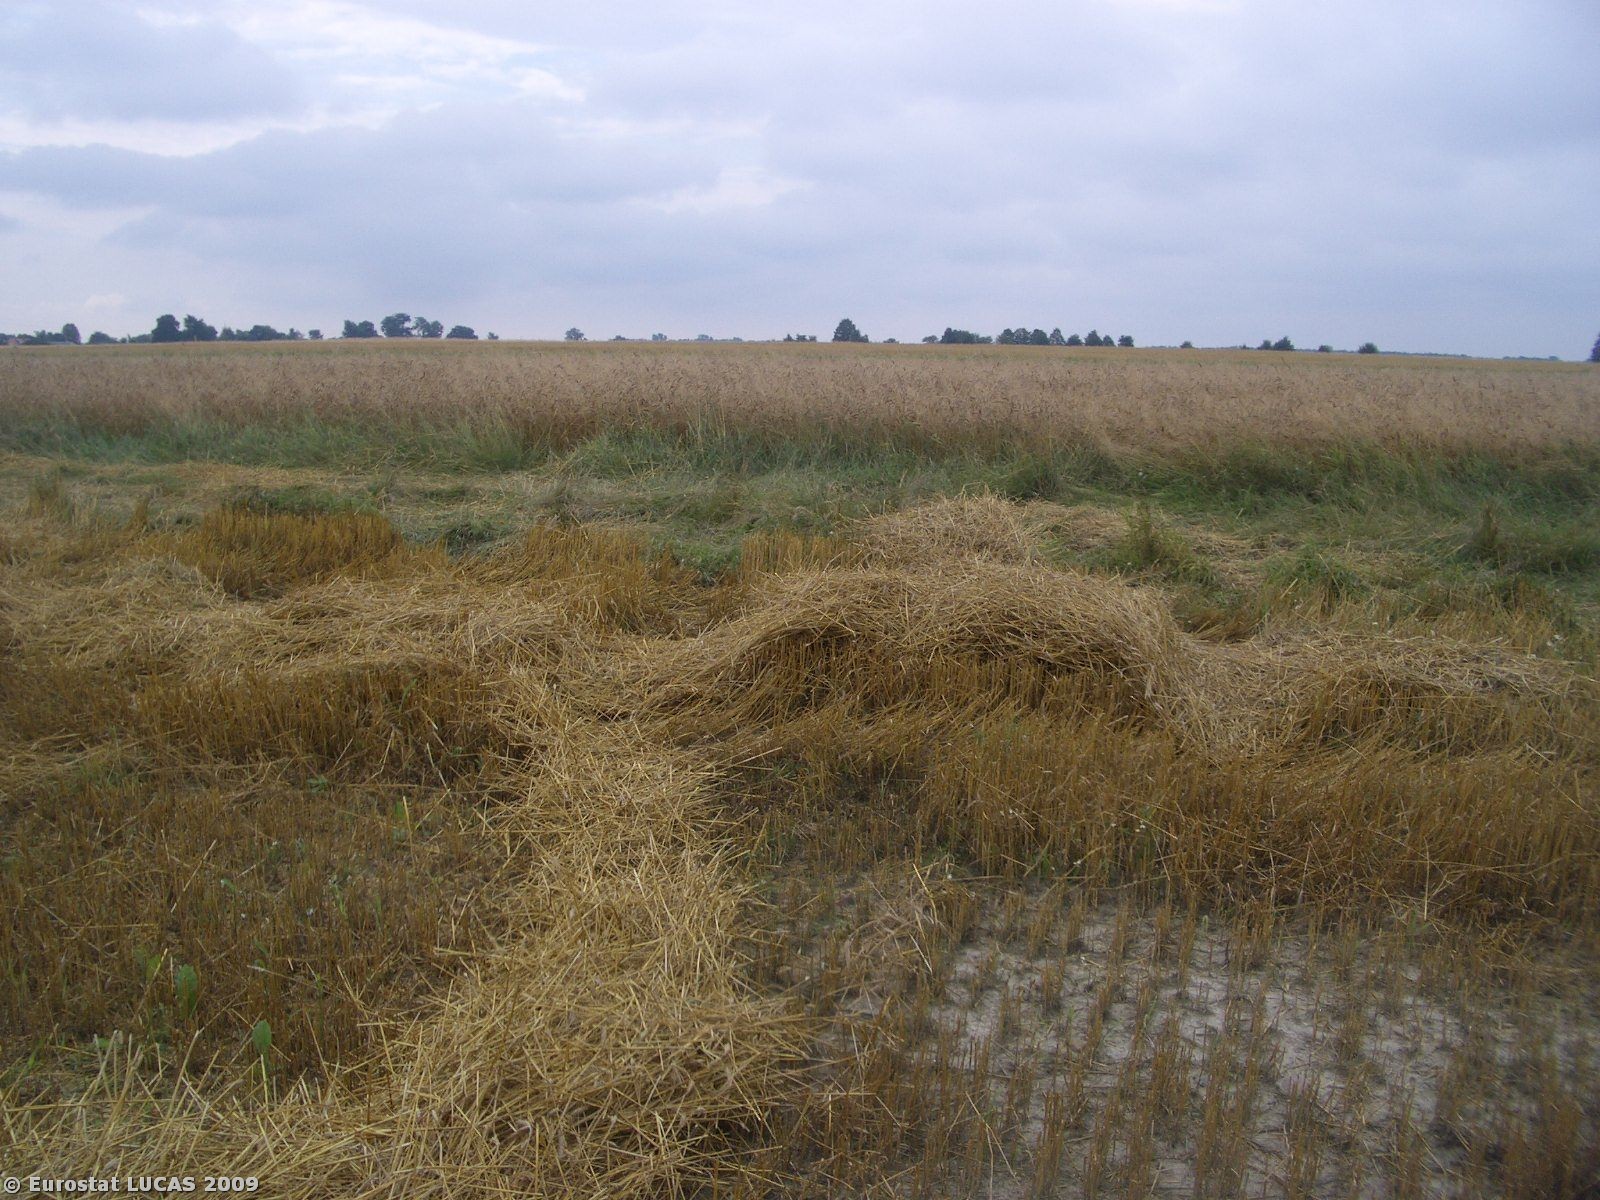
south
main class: Cropland
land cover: Triticale
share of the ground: < 10 %
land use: Agriculture (excluding fallow land and kitchen gardens)
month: July
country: PL
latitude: 51.8080
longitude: 22.9684
